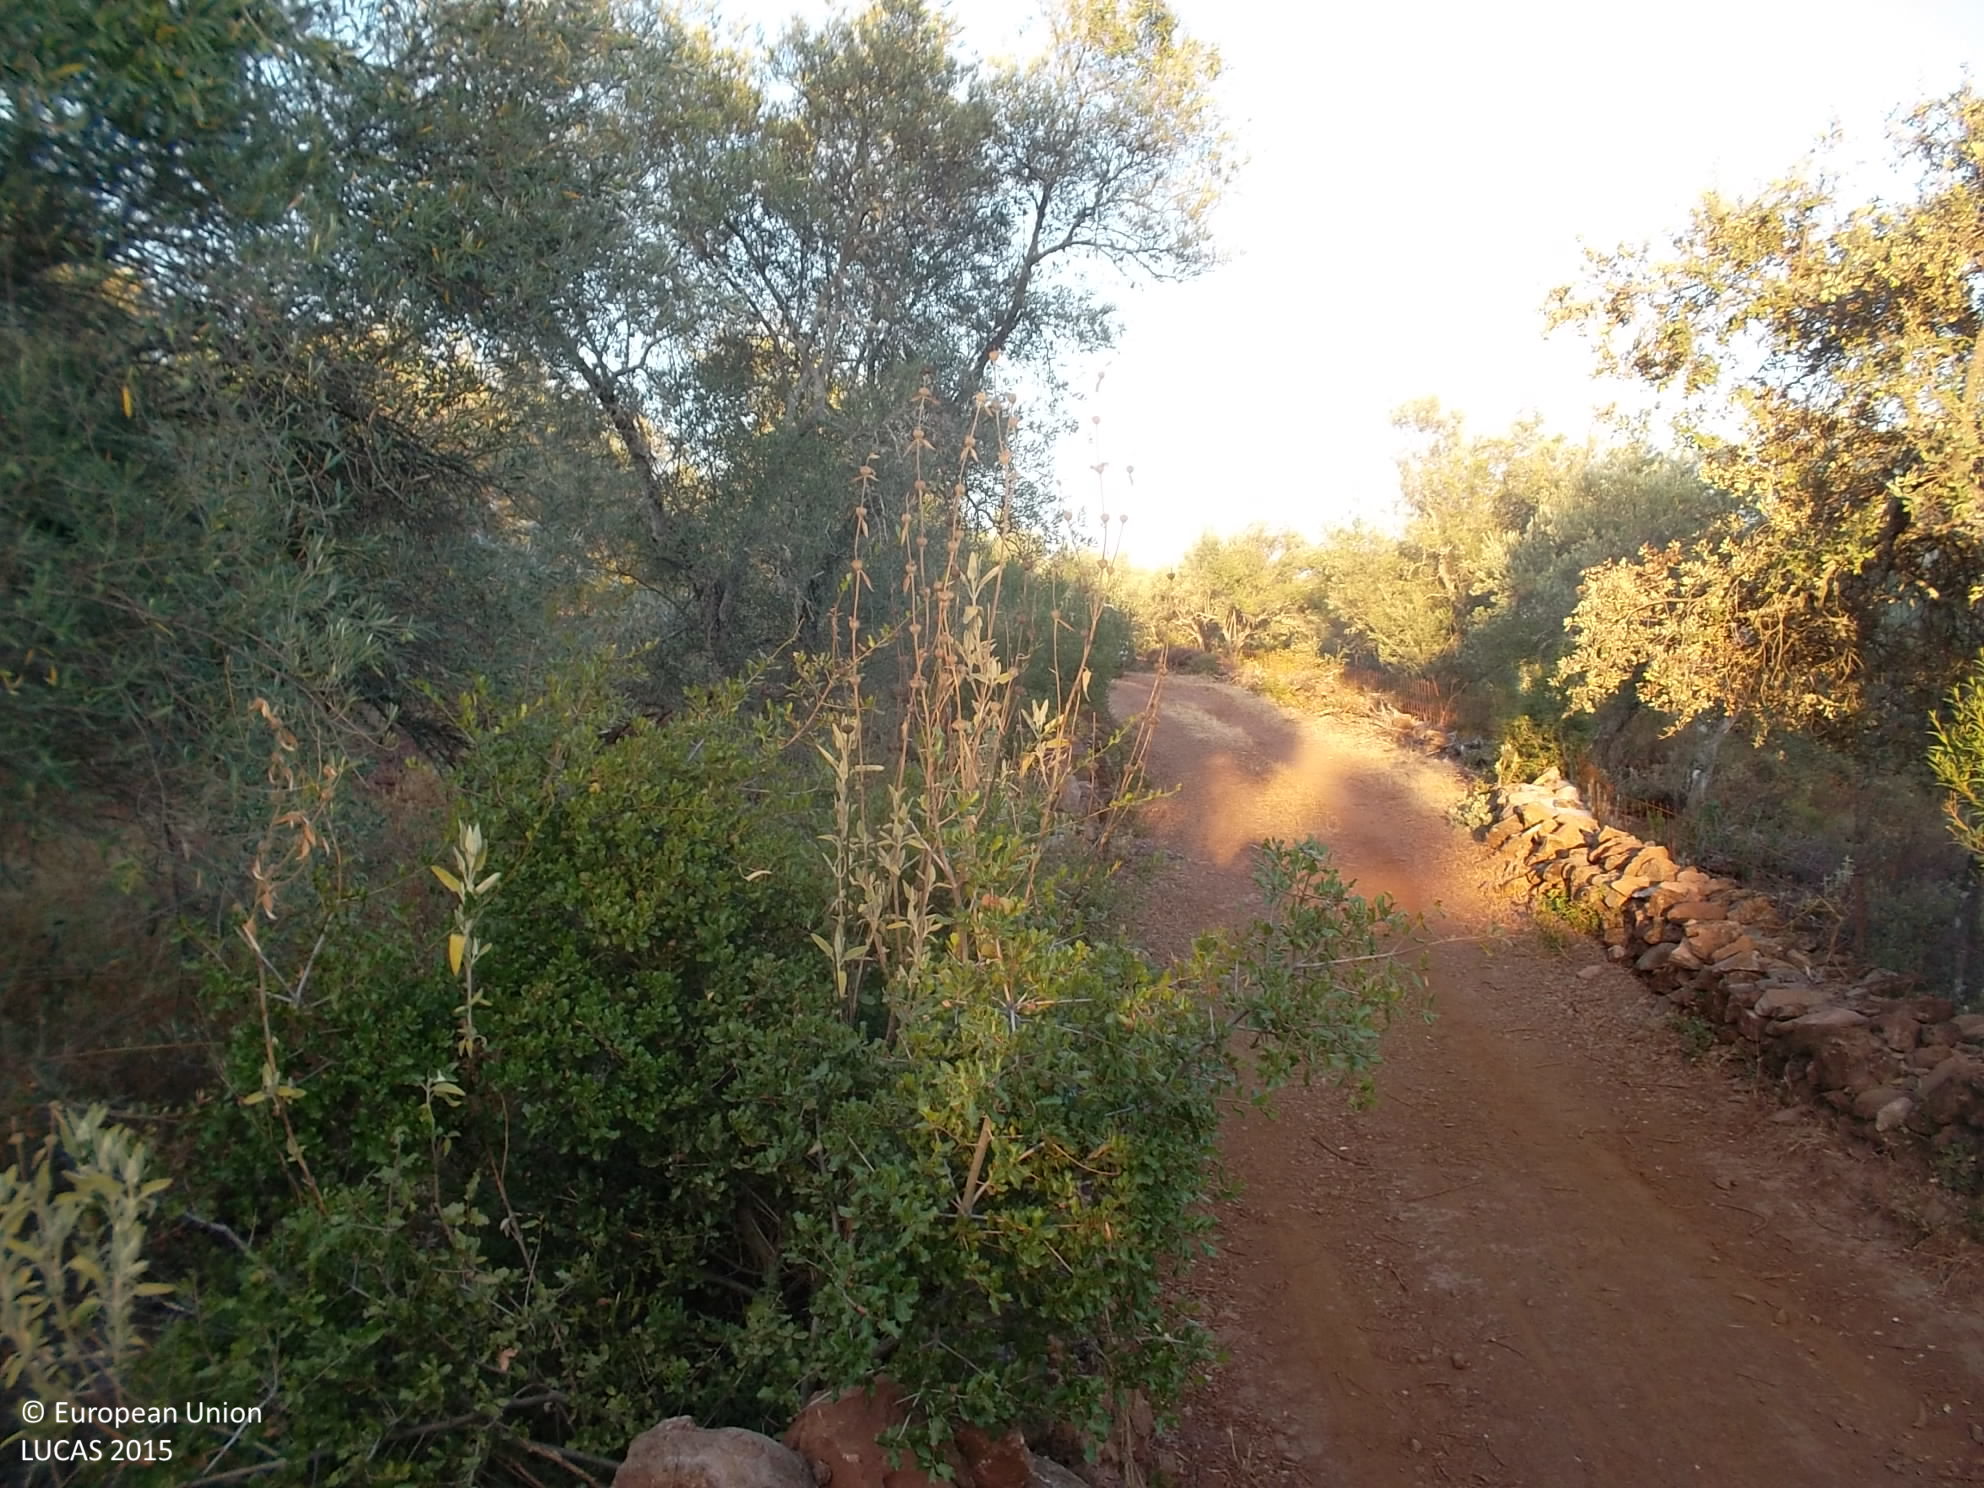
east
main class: Cropland
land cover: Olive groves
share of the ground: 25 - 50 %
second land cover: Shrubland without tree cover
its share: > 75 %
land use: Abandoned areas
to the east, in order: Tracks; Dry stone walls; Olive groves; Dry stone walls; Olive groves; Dry stone walls; Olive groves; Dry stone walls; Olive groves; Dry stone walls; Olive groves; Dry stone walls; Olive groves
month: September
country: ES
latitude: 38.0209
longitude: -6.5514
